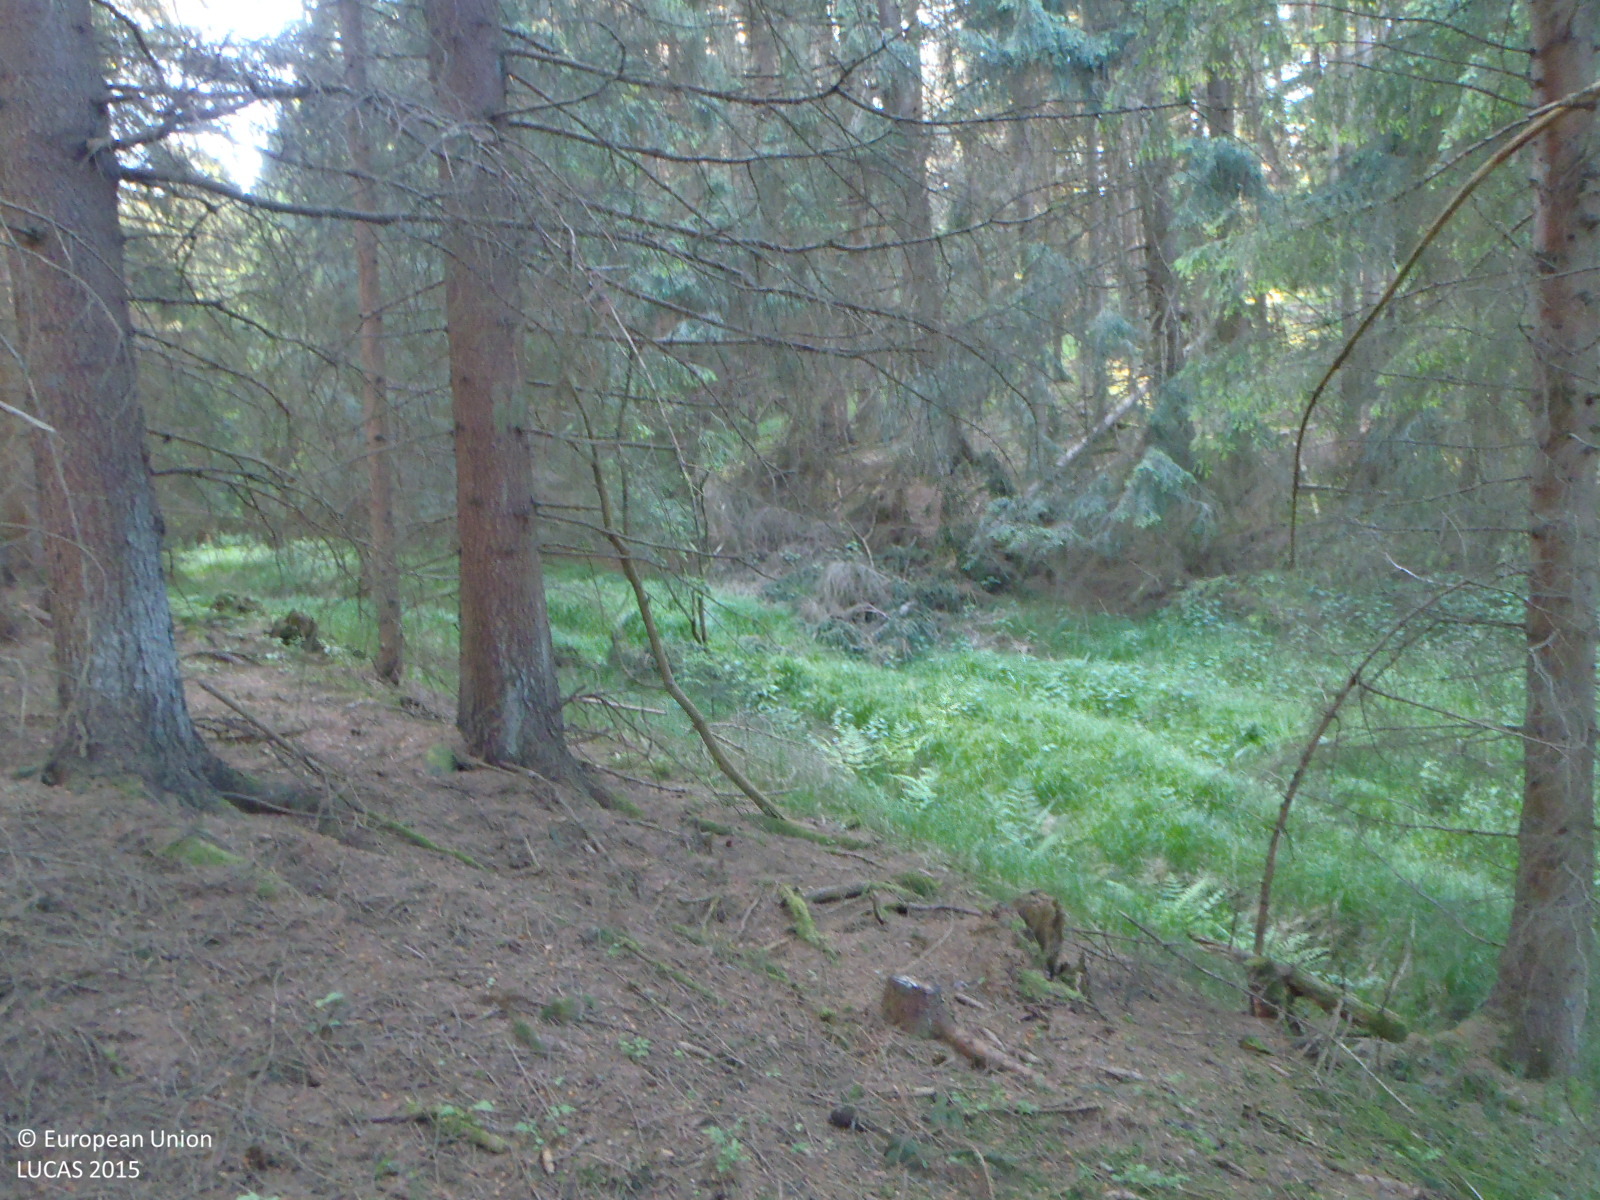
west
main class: Woodland
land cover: Spruce dominated coniferous woodland
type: hemiboreal forest and nemoral coniferous forest and mixed broadleaved-coniferous forest
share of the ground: > 75 %
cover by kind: coniferous forest trees 95 %, herbaceous plants 5 %
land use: Forestry
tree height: > 5 m
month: June
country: CZ
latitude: 48.5702
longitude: 14.3509
